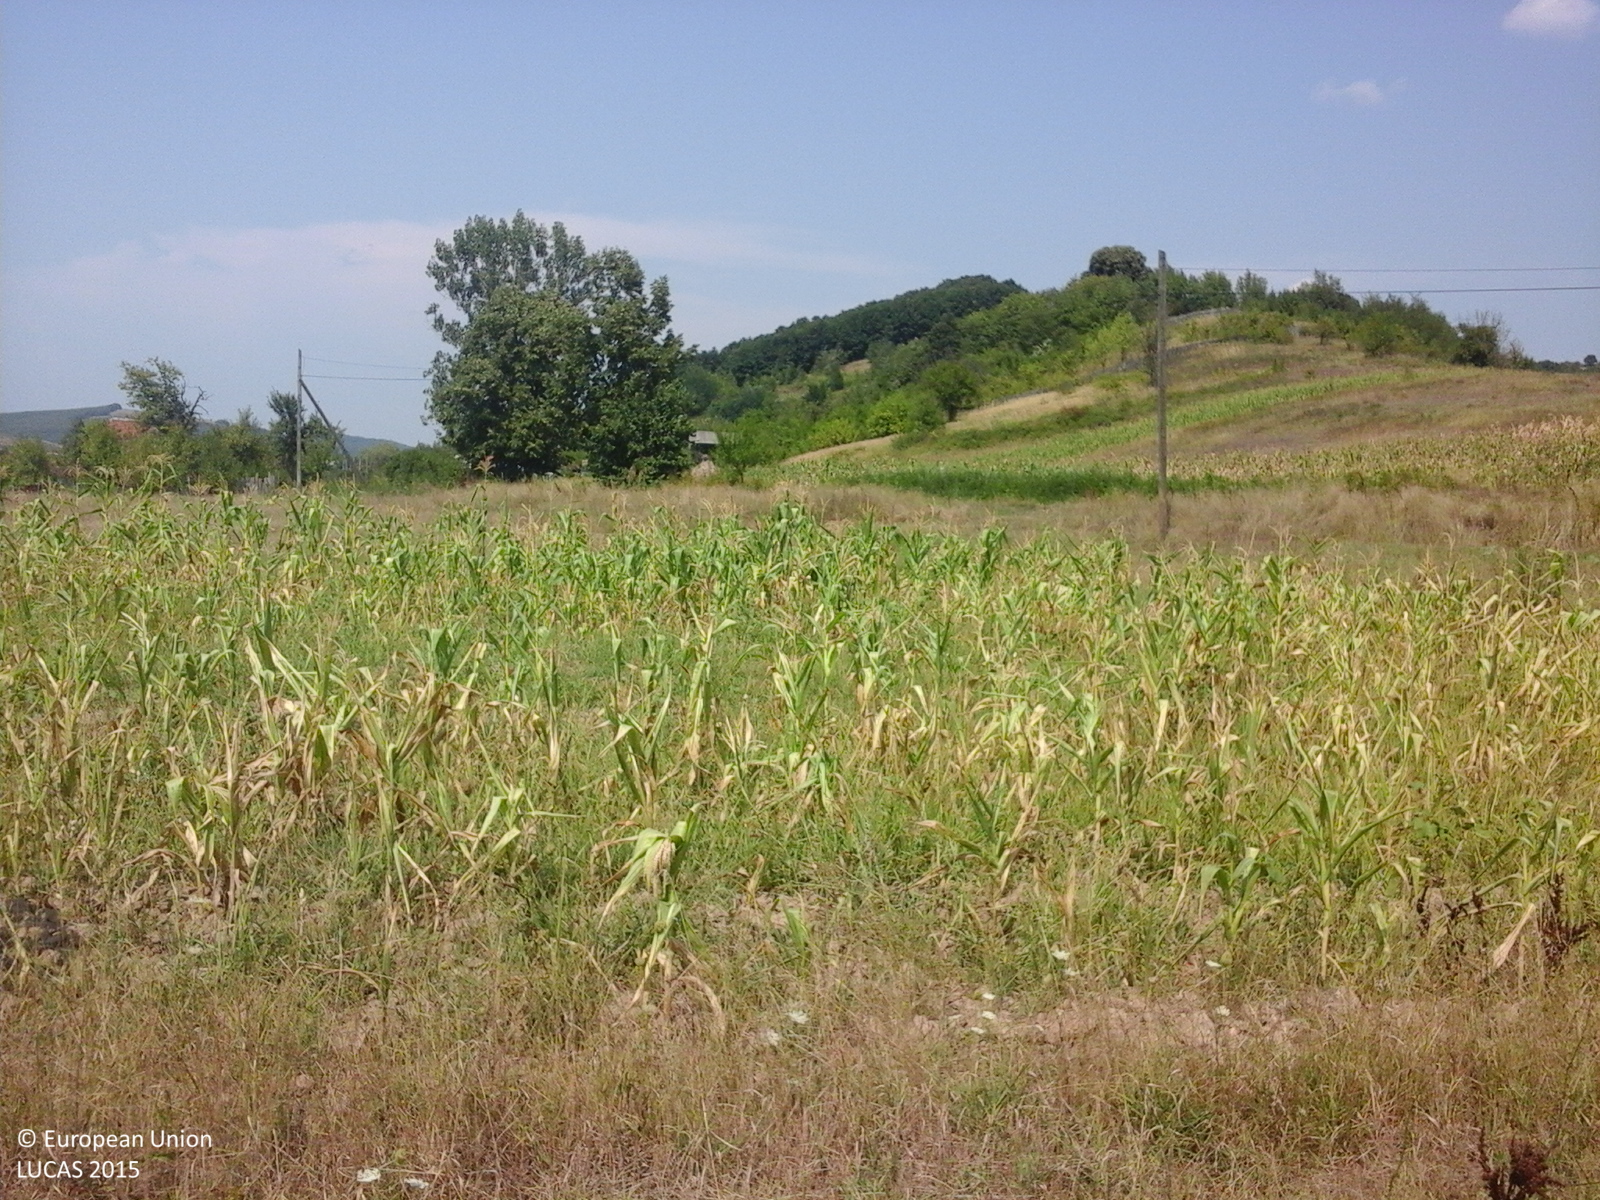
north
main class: Grassland
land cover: Grassland without tree/shrub cover
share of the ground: > 75 %
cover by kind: herbaceous plants 100 %
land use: Agriculture (excluding fallow land and kitchen gardens)
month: August
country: RO
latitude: 44.6733
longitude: 23.7455
